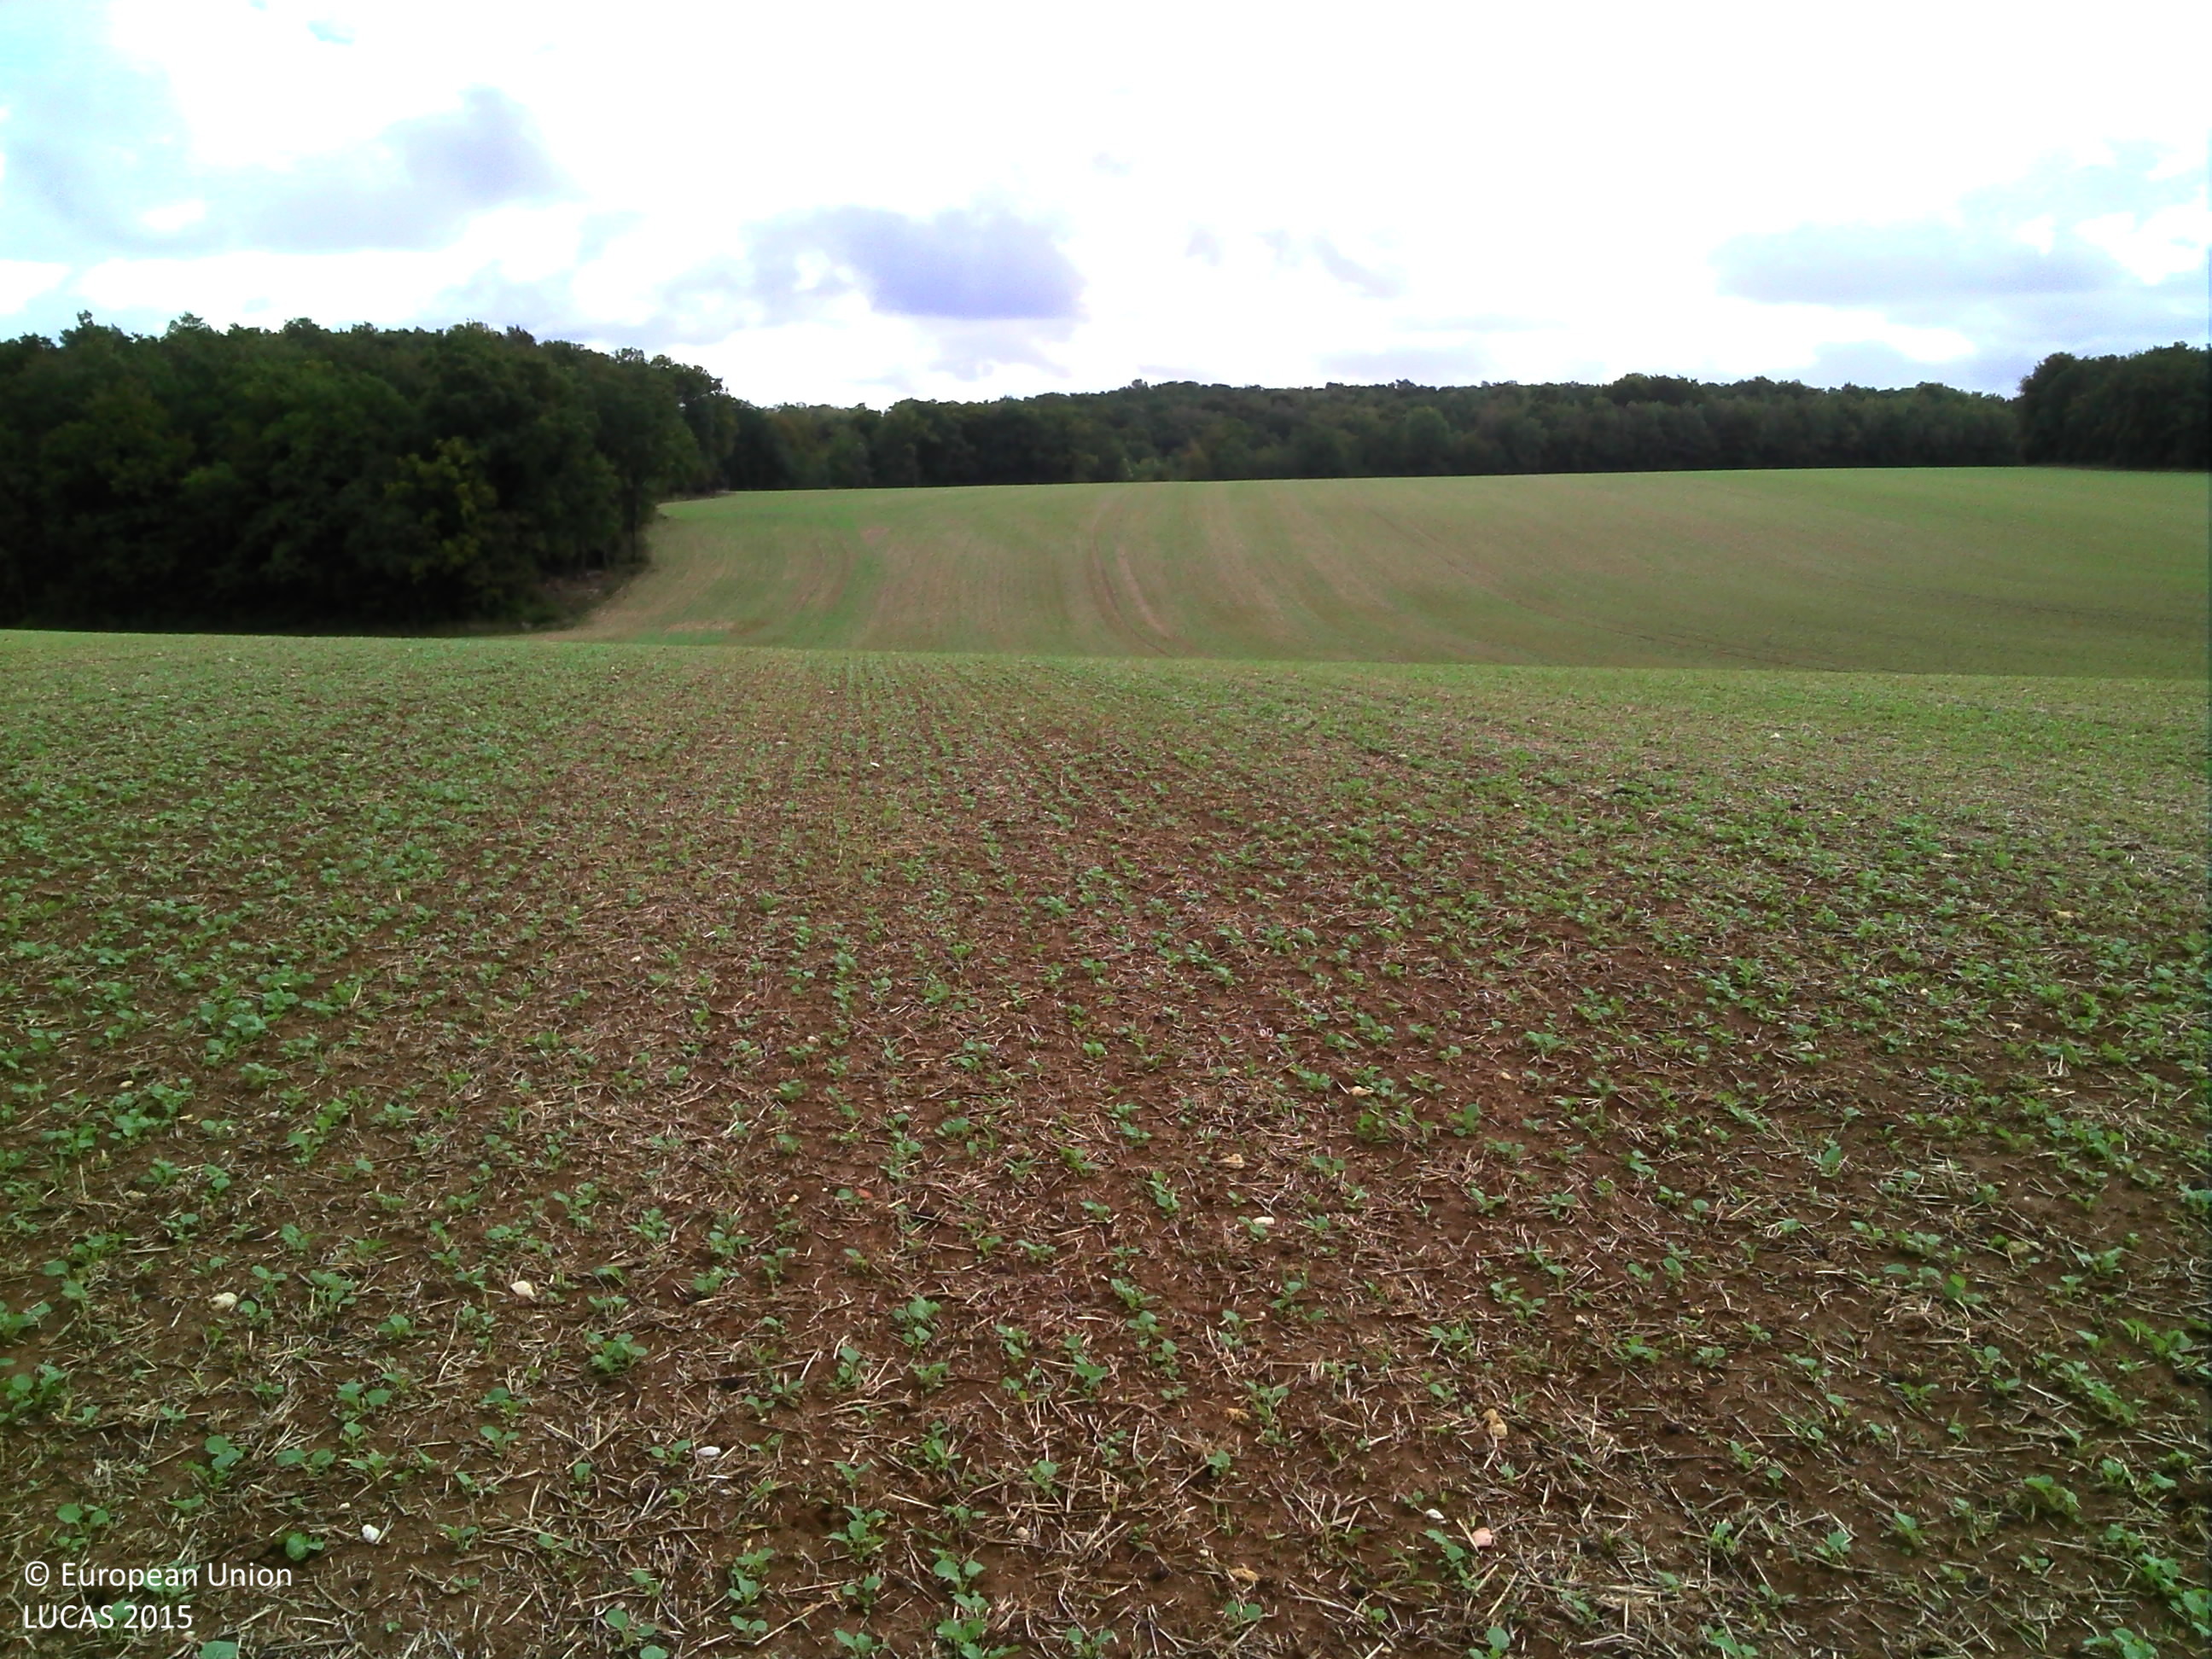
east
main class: Cropland
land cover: Rape and turnip rape
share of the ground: 25 - 50 %
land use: Agriculture (excluding fallow land and kitchen gardens)
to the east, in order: Rape and turnip rape
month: September
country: FR
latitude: 48.2971
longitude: 4.7544
